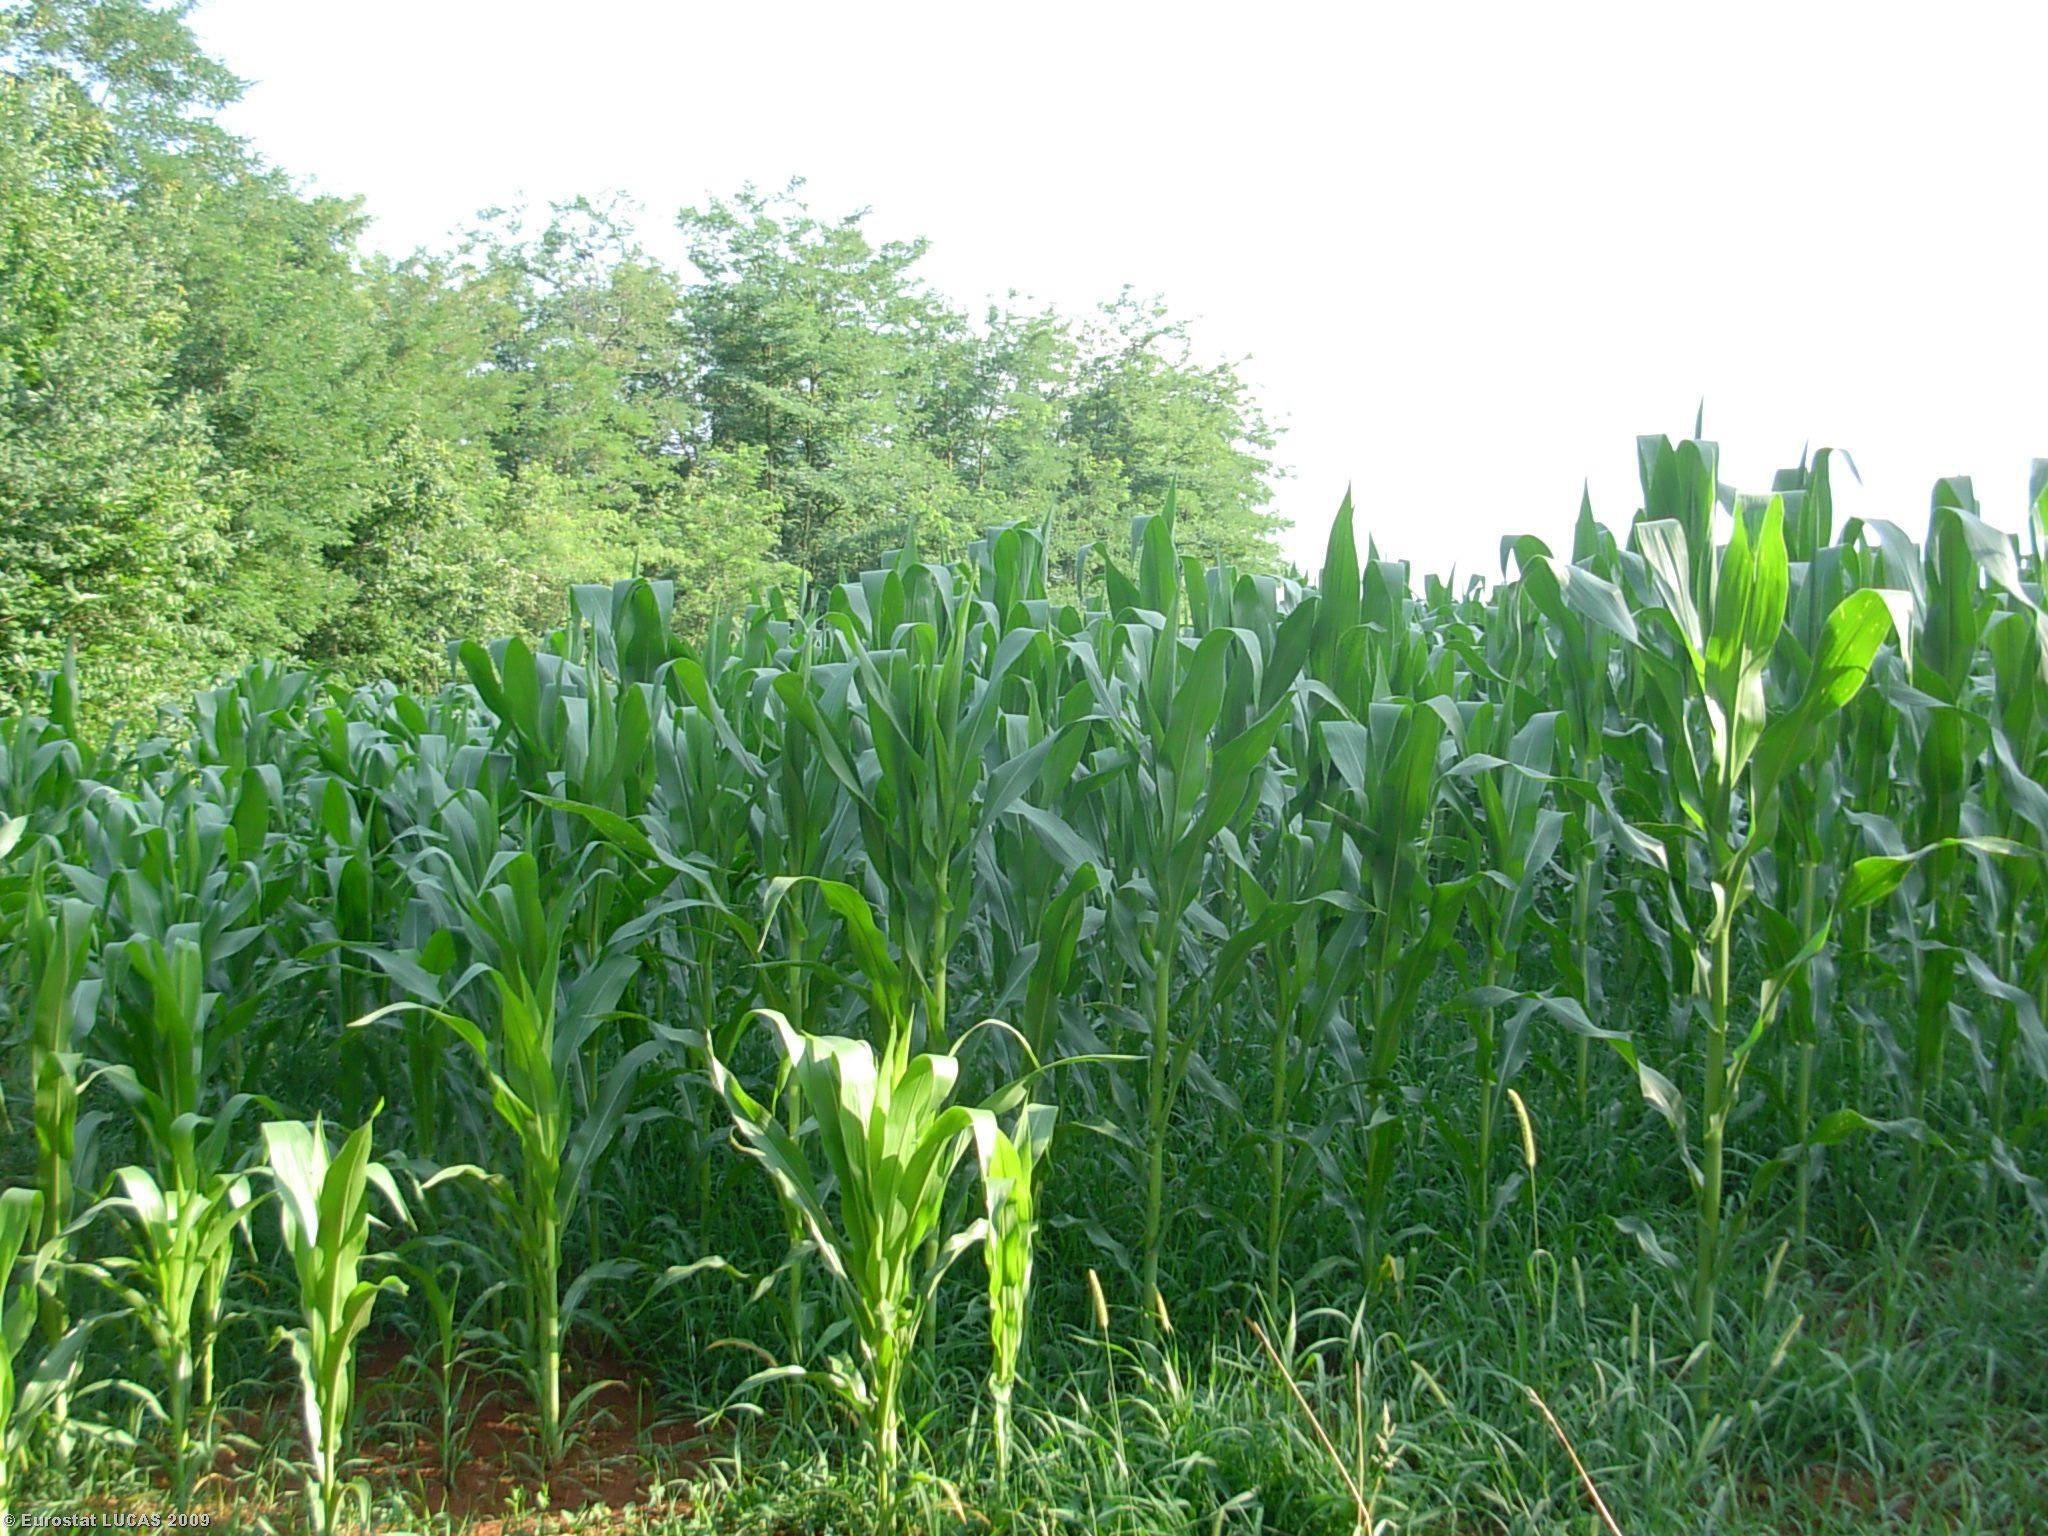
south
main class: Woodland
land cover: Broadleaved woodland
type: mesophytic deciduous forest
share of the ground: > 75 %
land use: Agriculture (excluding fallow land and kitchen gardens)
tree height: > 5 m
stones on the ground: < 10 %
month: July
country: IT
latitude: 45.6642
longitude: 9.2952
